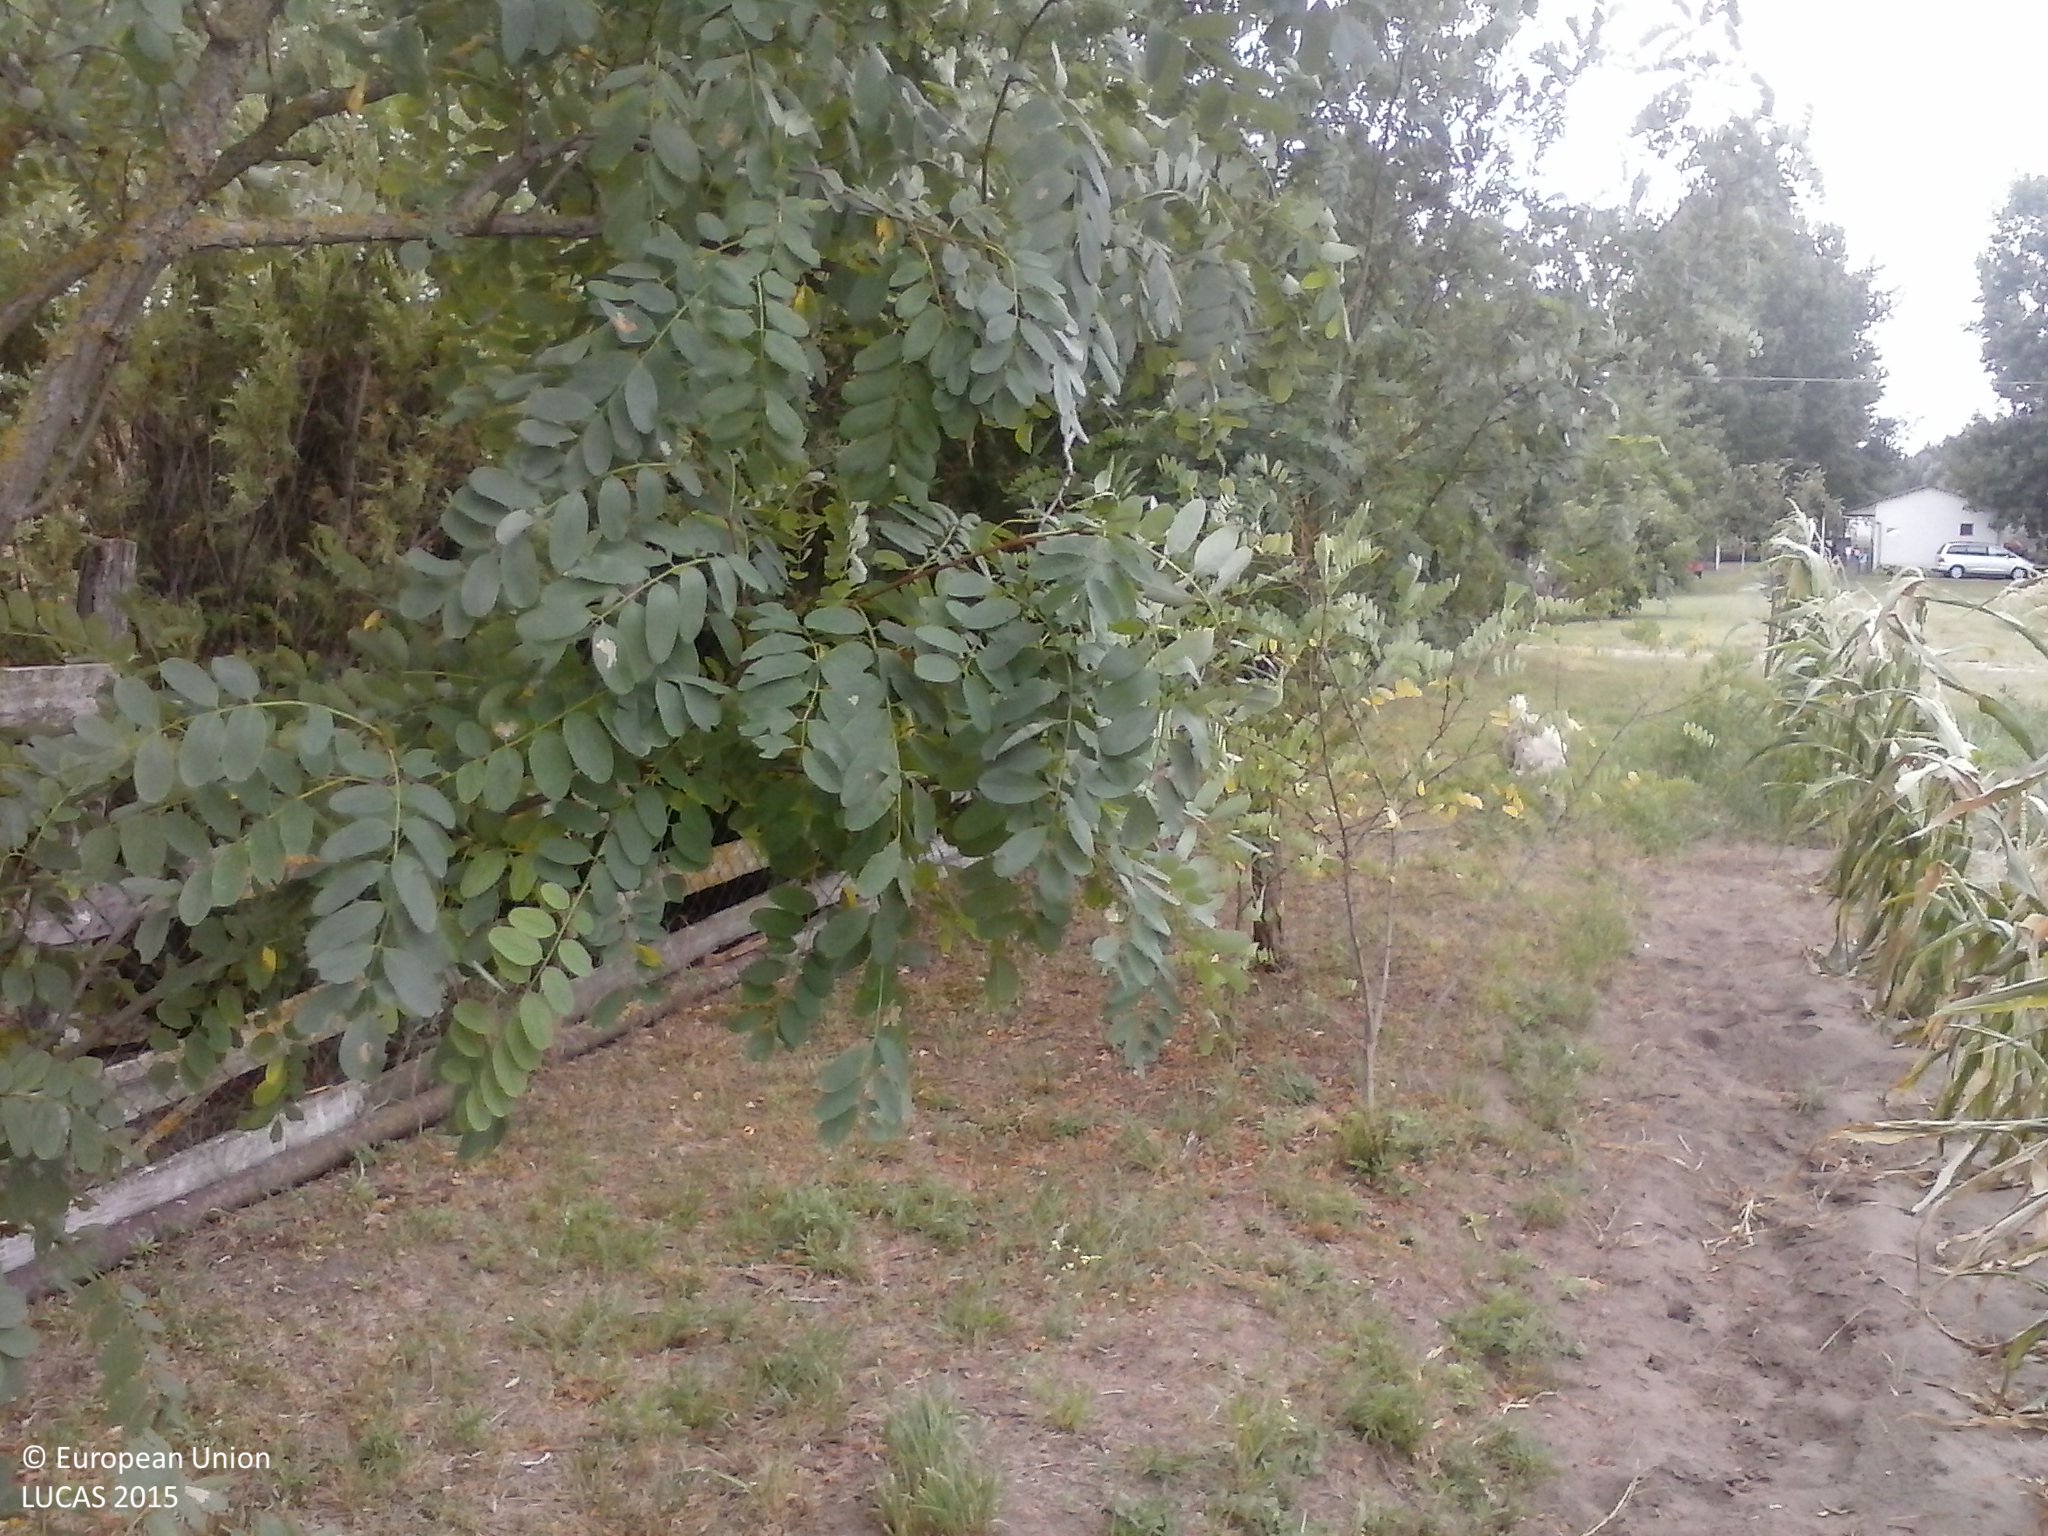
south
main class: Cropland
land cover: Maize
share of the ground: 10 - 25 %
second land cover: Spontaneously vegetated surfaces
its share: > 75 %
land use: Kitchen garden
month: July
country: HU
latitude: 46.5611
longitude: 19.7118
